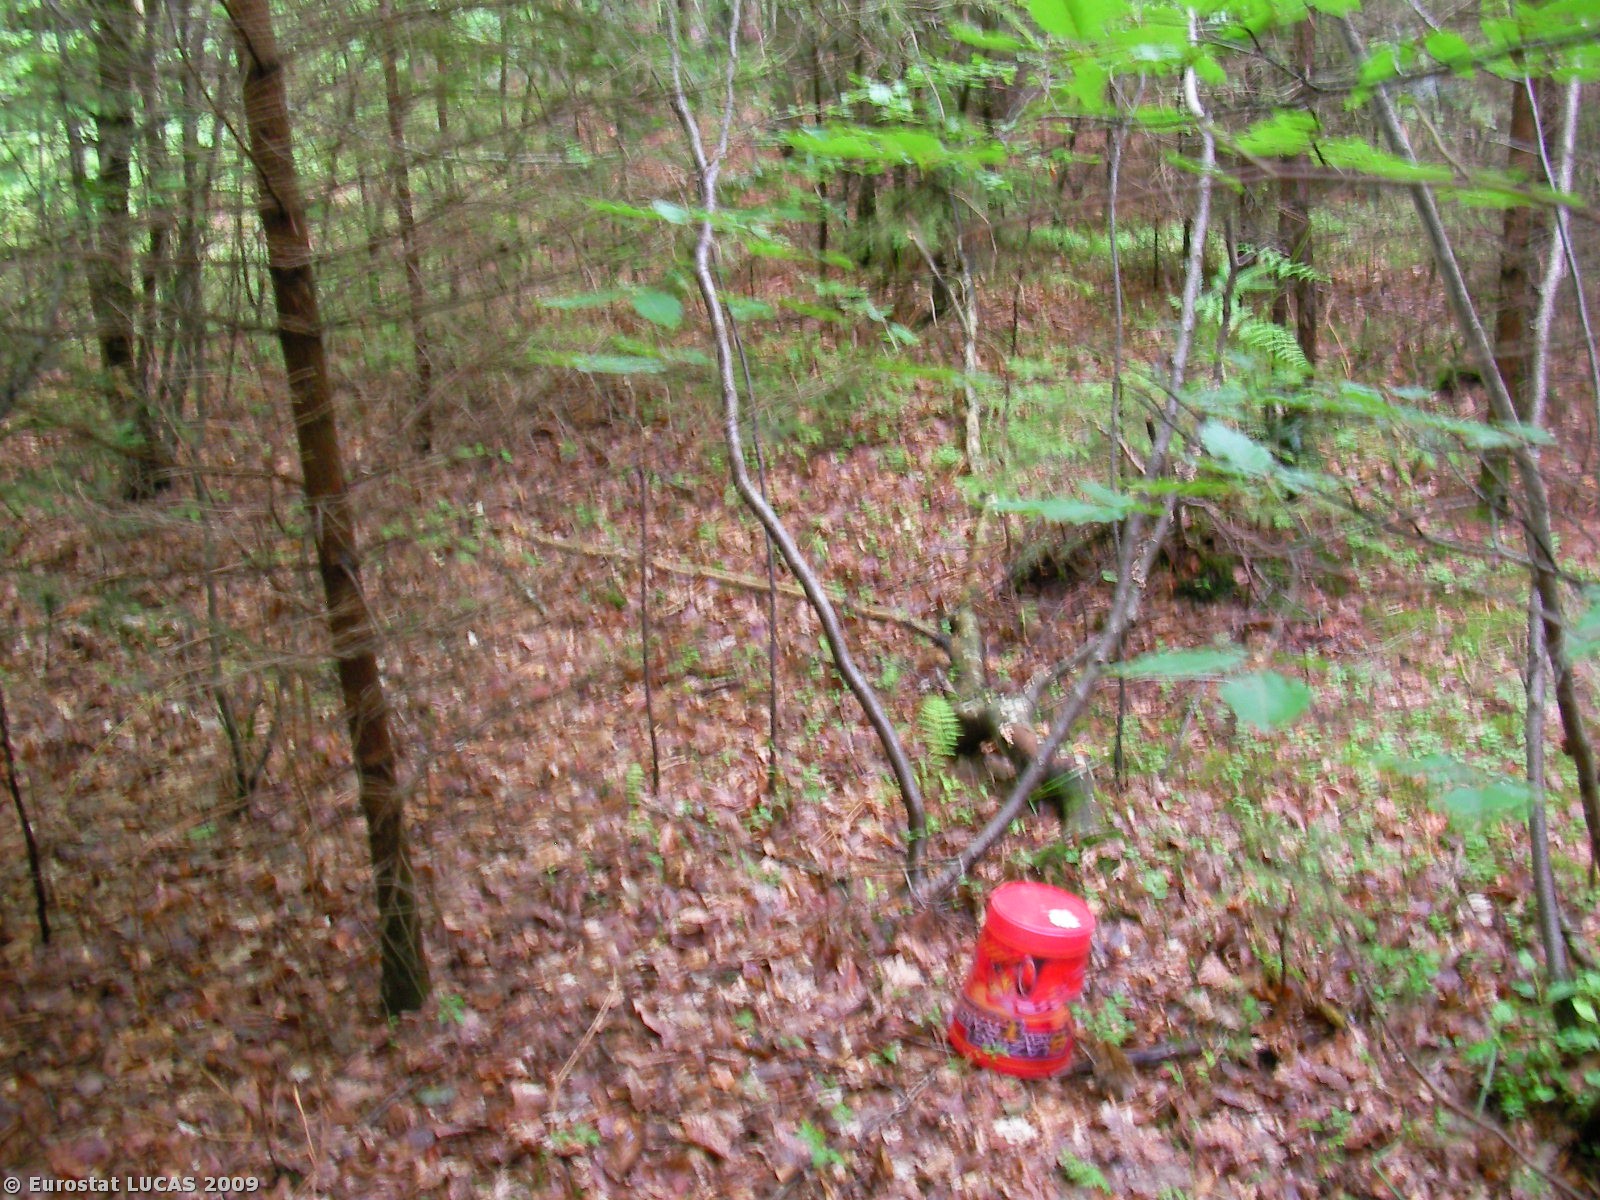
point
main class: Woodland
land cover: Coniferous woodland
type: hemiboreal forest and nemoral coniferous forest and mixed broadleaved-coniferous forest
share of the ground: > 75 %
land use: Forestry
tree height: > 5 m
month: June
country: AT
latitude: 47.1898
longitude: 15.7419
